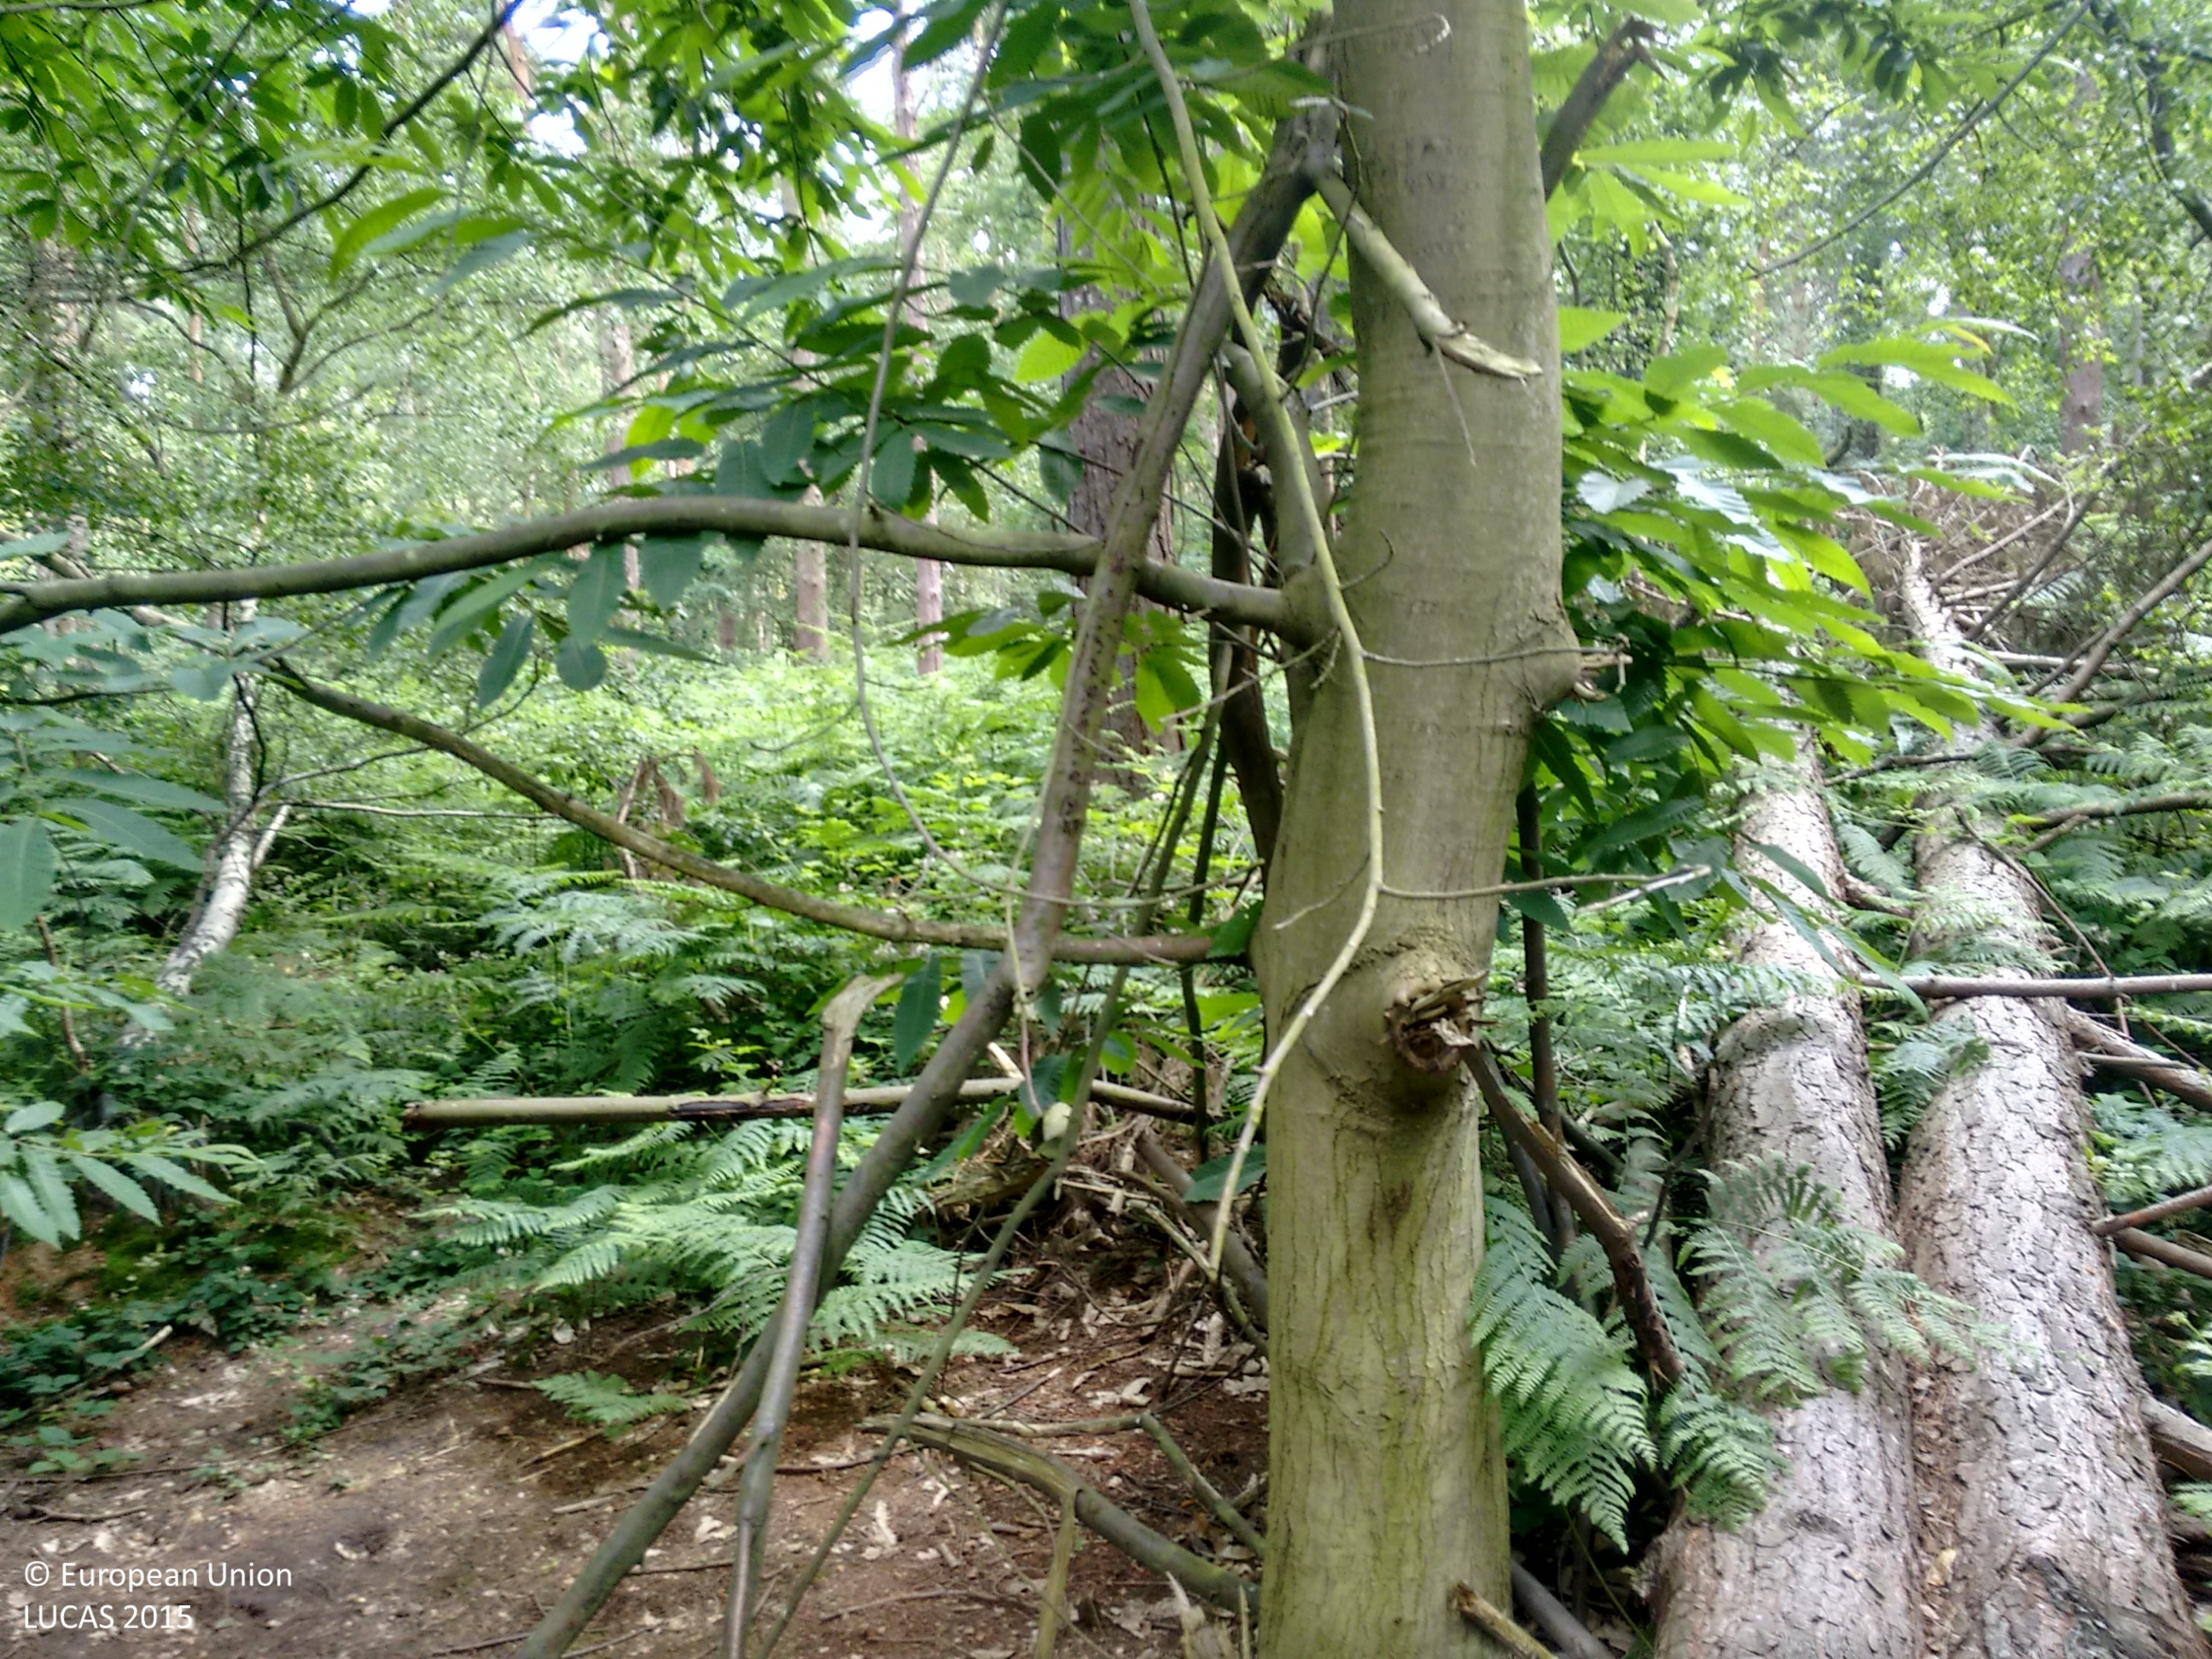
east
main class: Woodland
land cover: Pine dominated coniferous woodland
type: exotic forest
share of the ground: > 75 %
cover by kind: coniferous forest trees 90 %, broadleaved forest trees 10 %
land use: Forestry
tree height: > 5 m
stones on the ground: < 10 %
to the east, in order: Pine dominated coniferous woodland; Spruce dominated mixed woodland
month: July
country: GB
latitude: 53.2947
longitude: -1.0413
